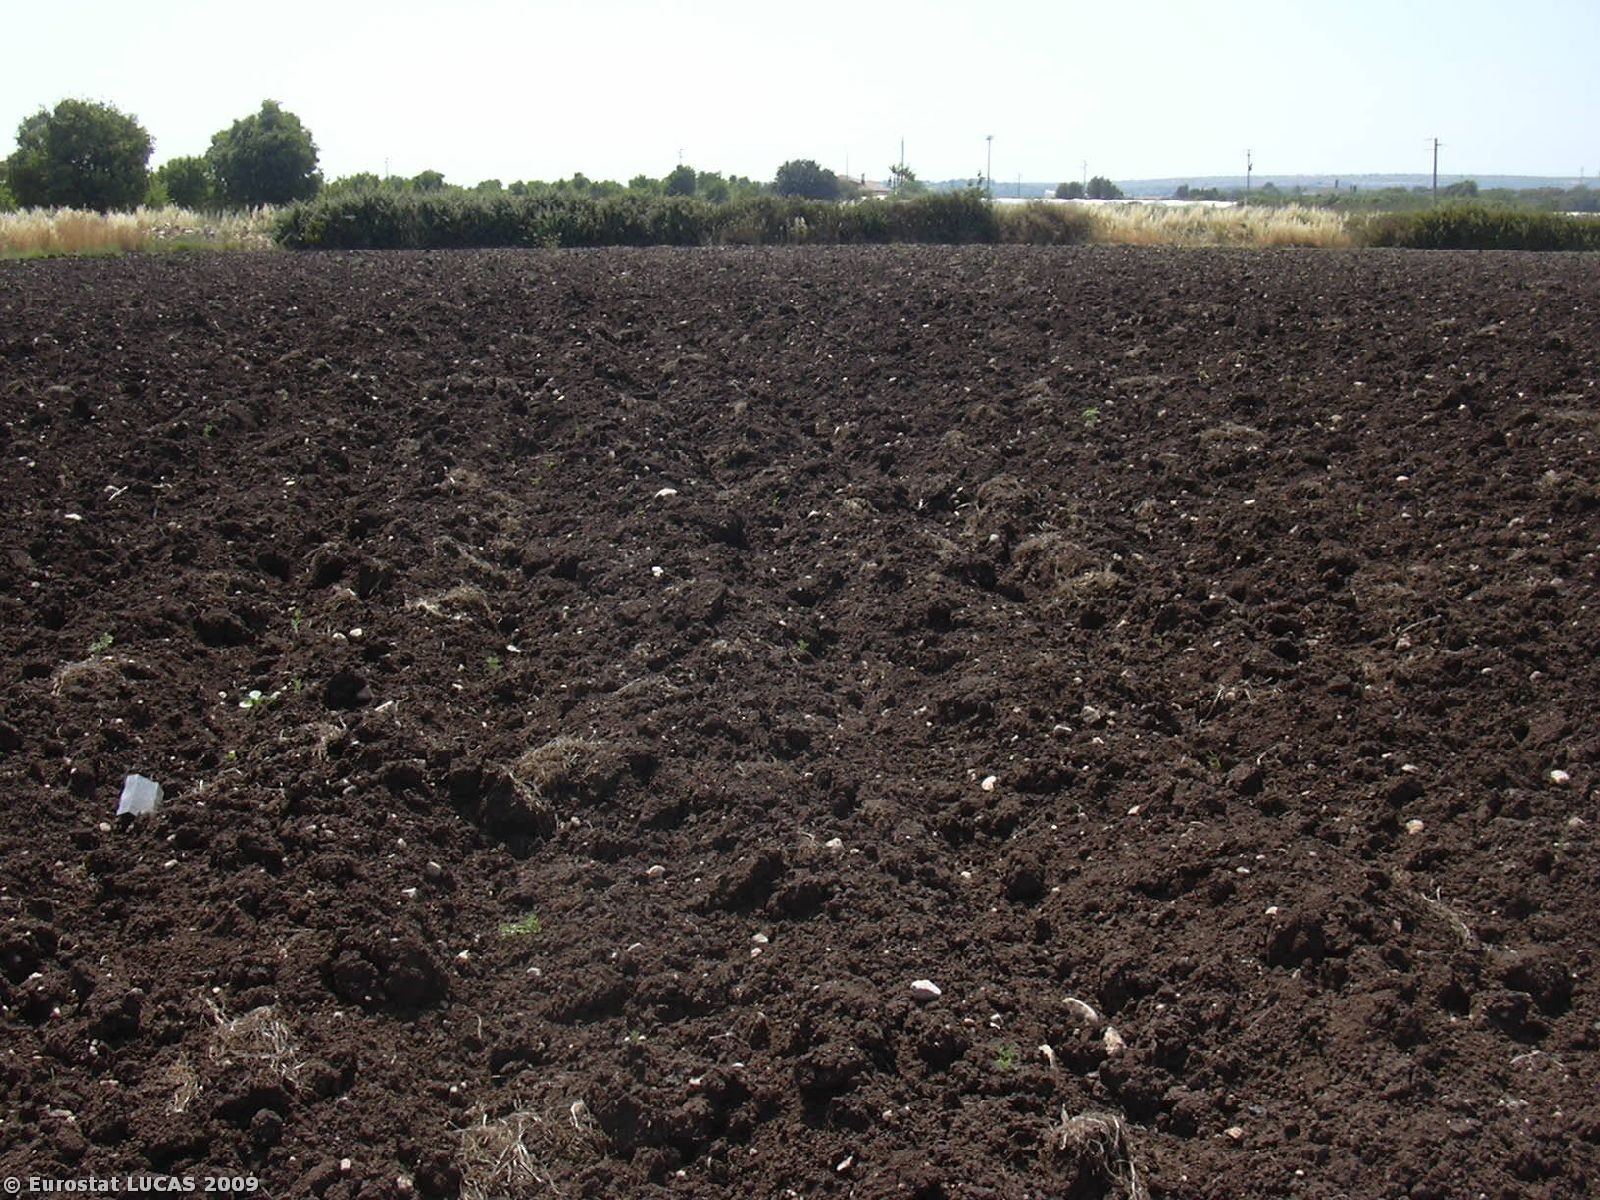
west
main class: Bare land
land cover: Bare land
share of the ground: < 10 %
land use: Agriculture (excluding fallow land and kitchen gardens)
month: May
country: IT
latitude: 36.7468
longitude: 14.9218
